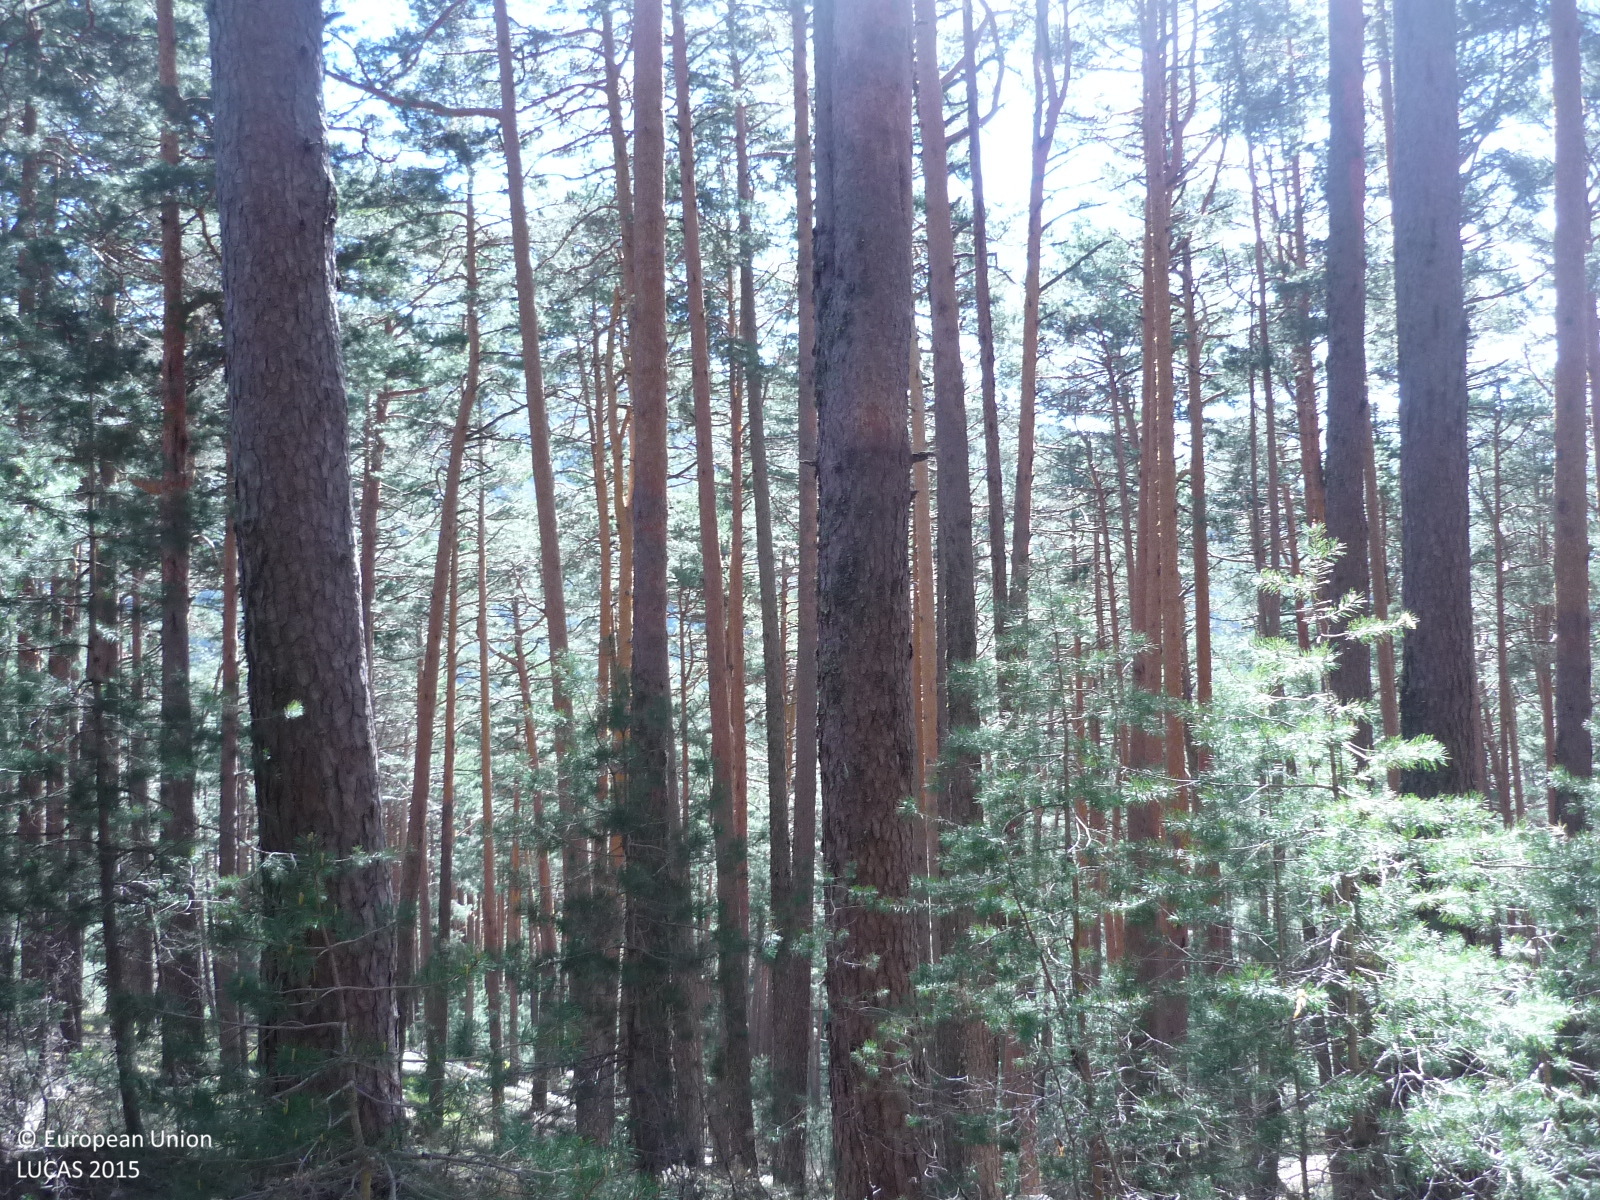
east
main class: Woodland
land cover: Pine dominated coniferous woodland
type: coniferous forest of the mediterranean region
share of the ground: > 75 %
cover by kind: coniferous forest trees 90 %, herbaceous plants 10 %
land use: Forestry
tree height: > 5 m
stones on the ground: < 10 %
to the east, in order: Pine dominated coniferous woodland
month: May
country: ES
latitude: 40.8300
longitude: -4.0281
